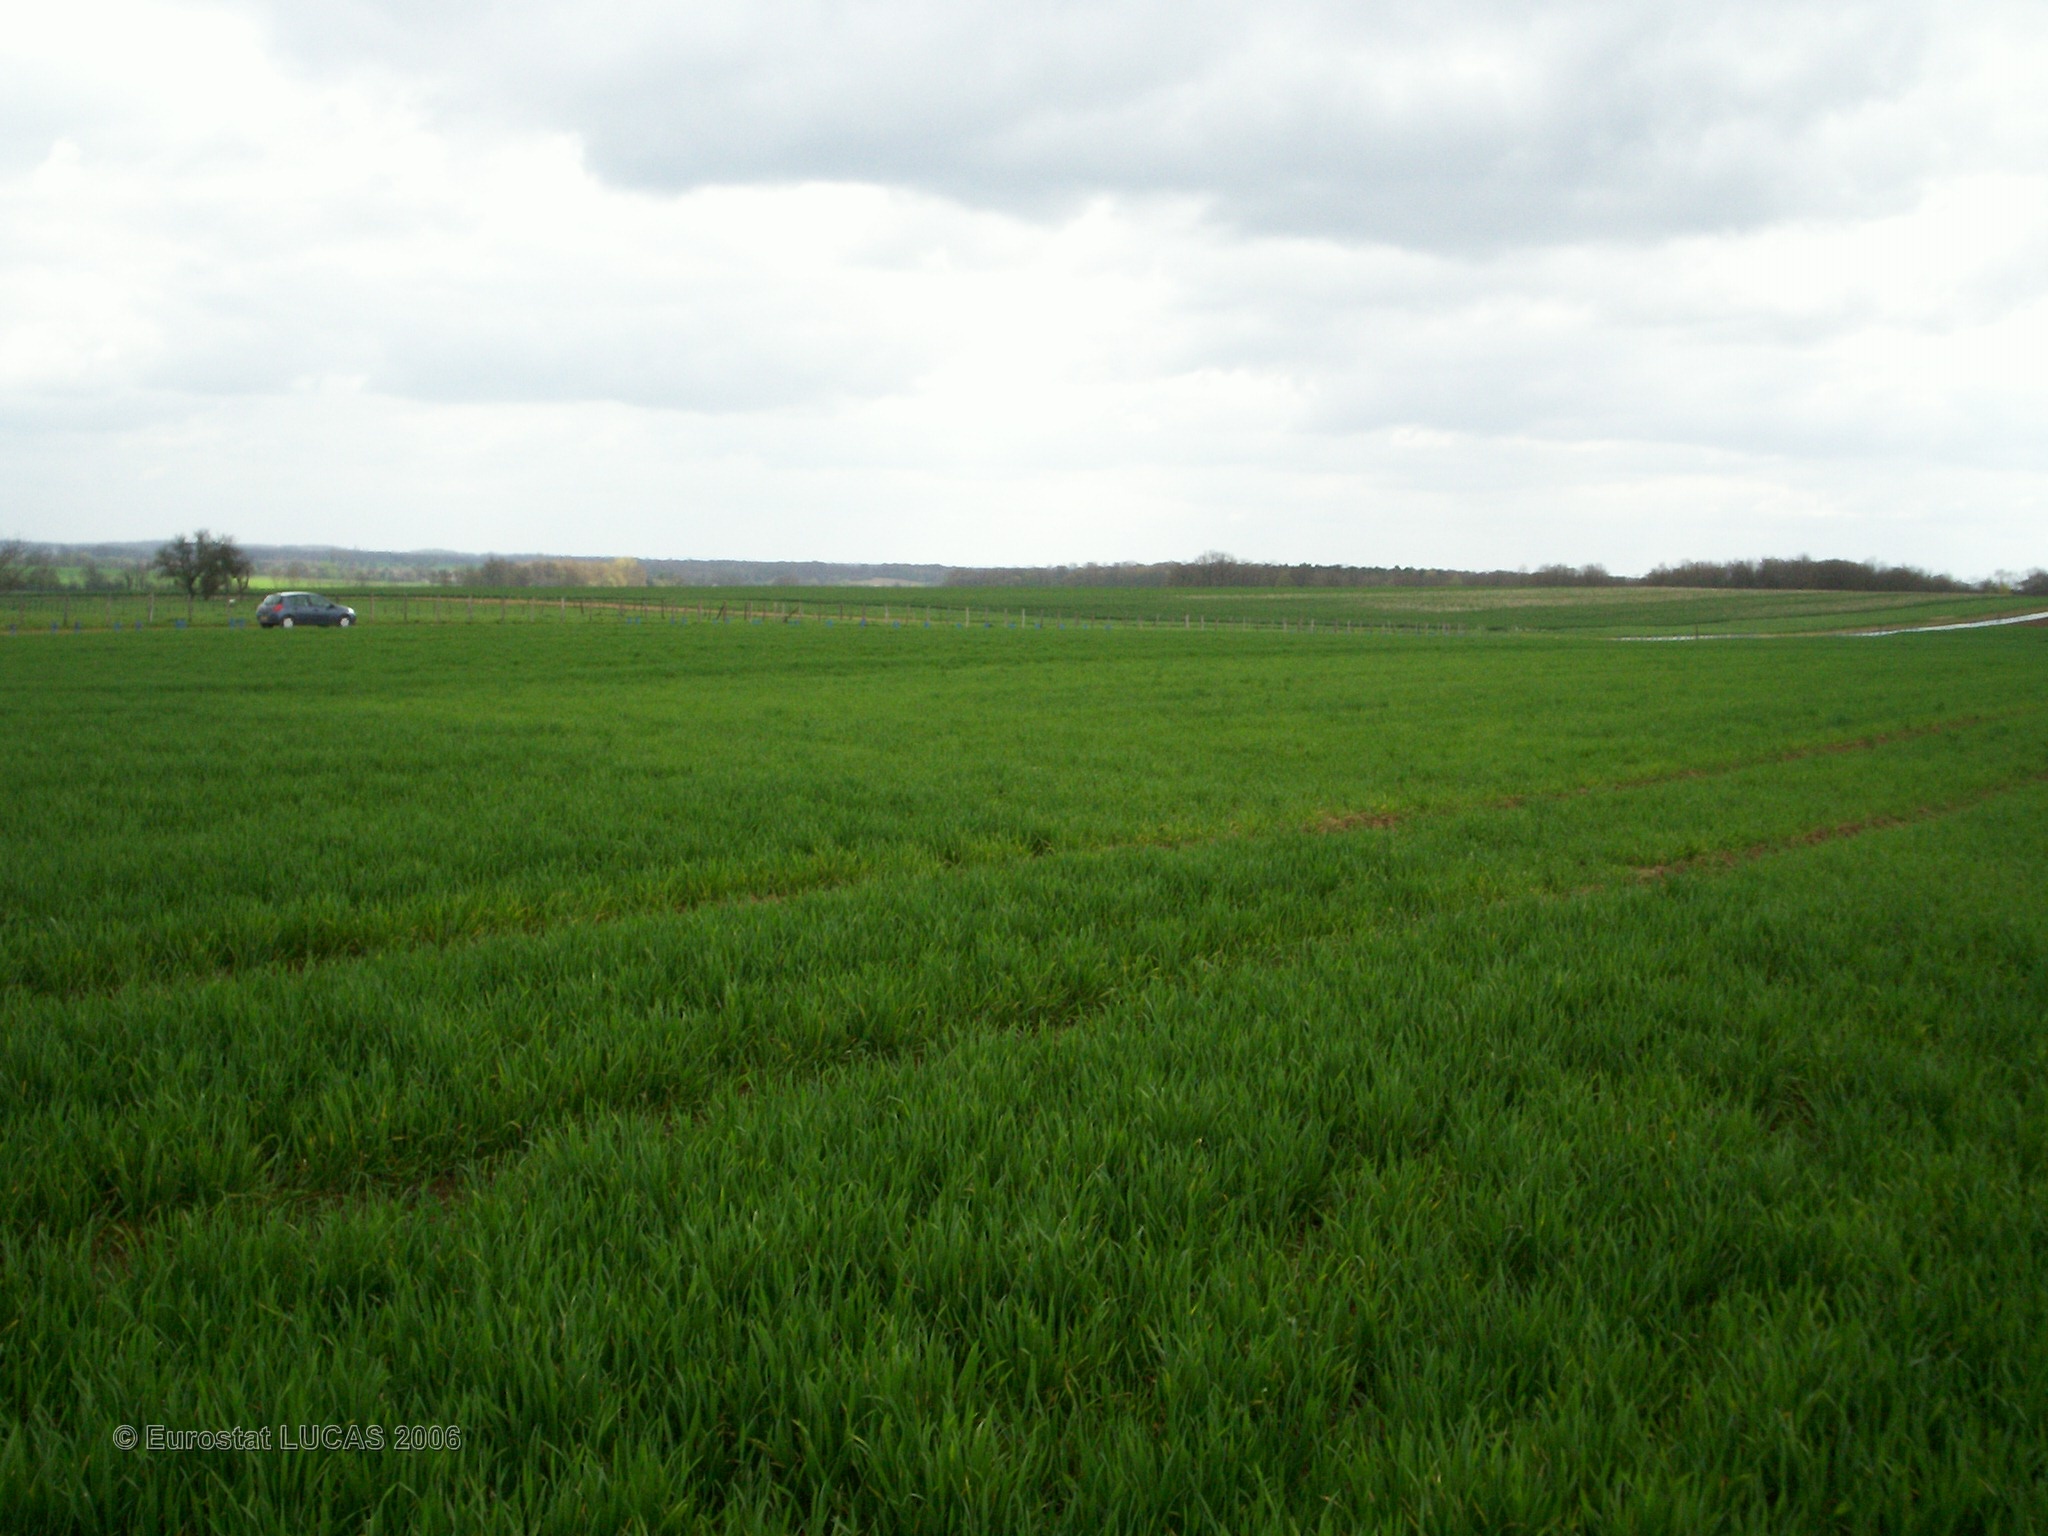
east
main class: Cropland
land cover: Common wheat
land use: Agriculture (excluding fallow land and kitchen gardens)
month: April
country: FR
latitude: 48.0497
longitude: 3.8115
